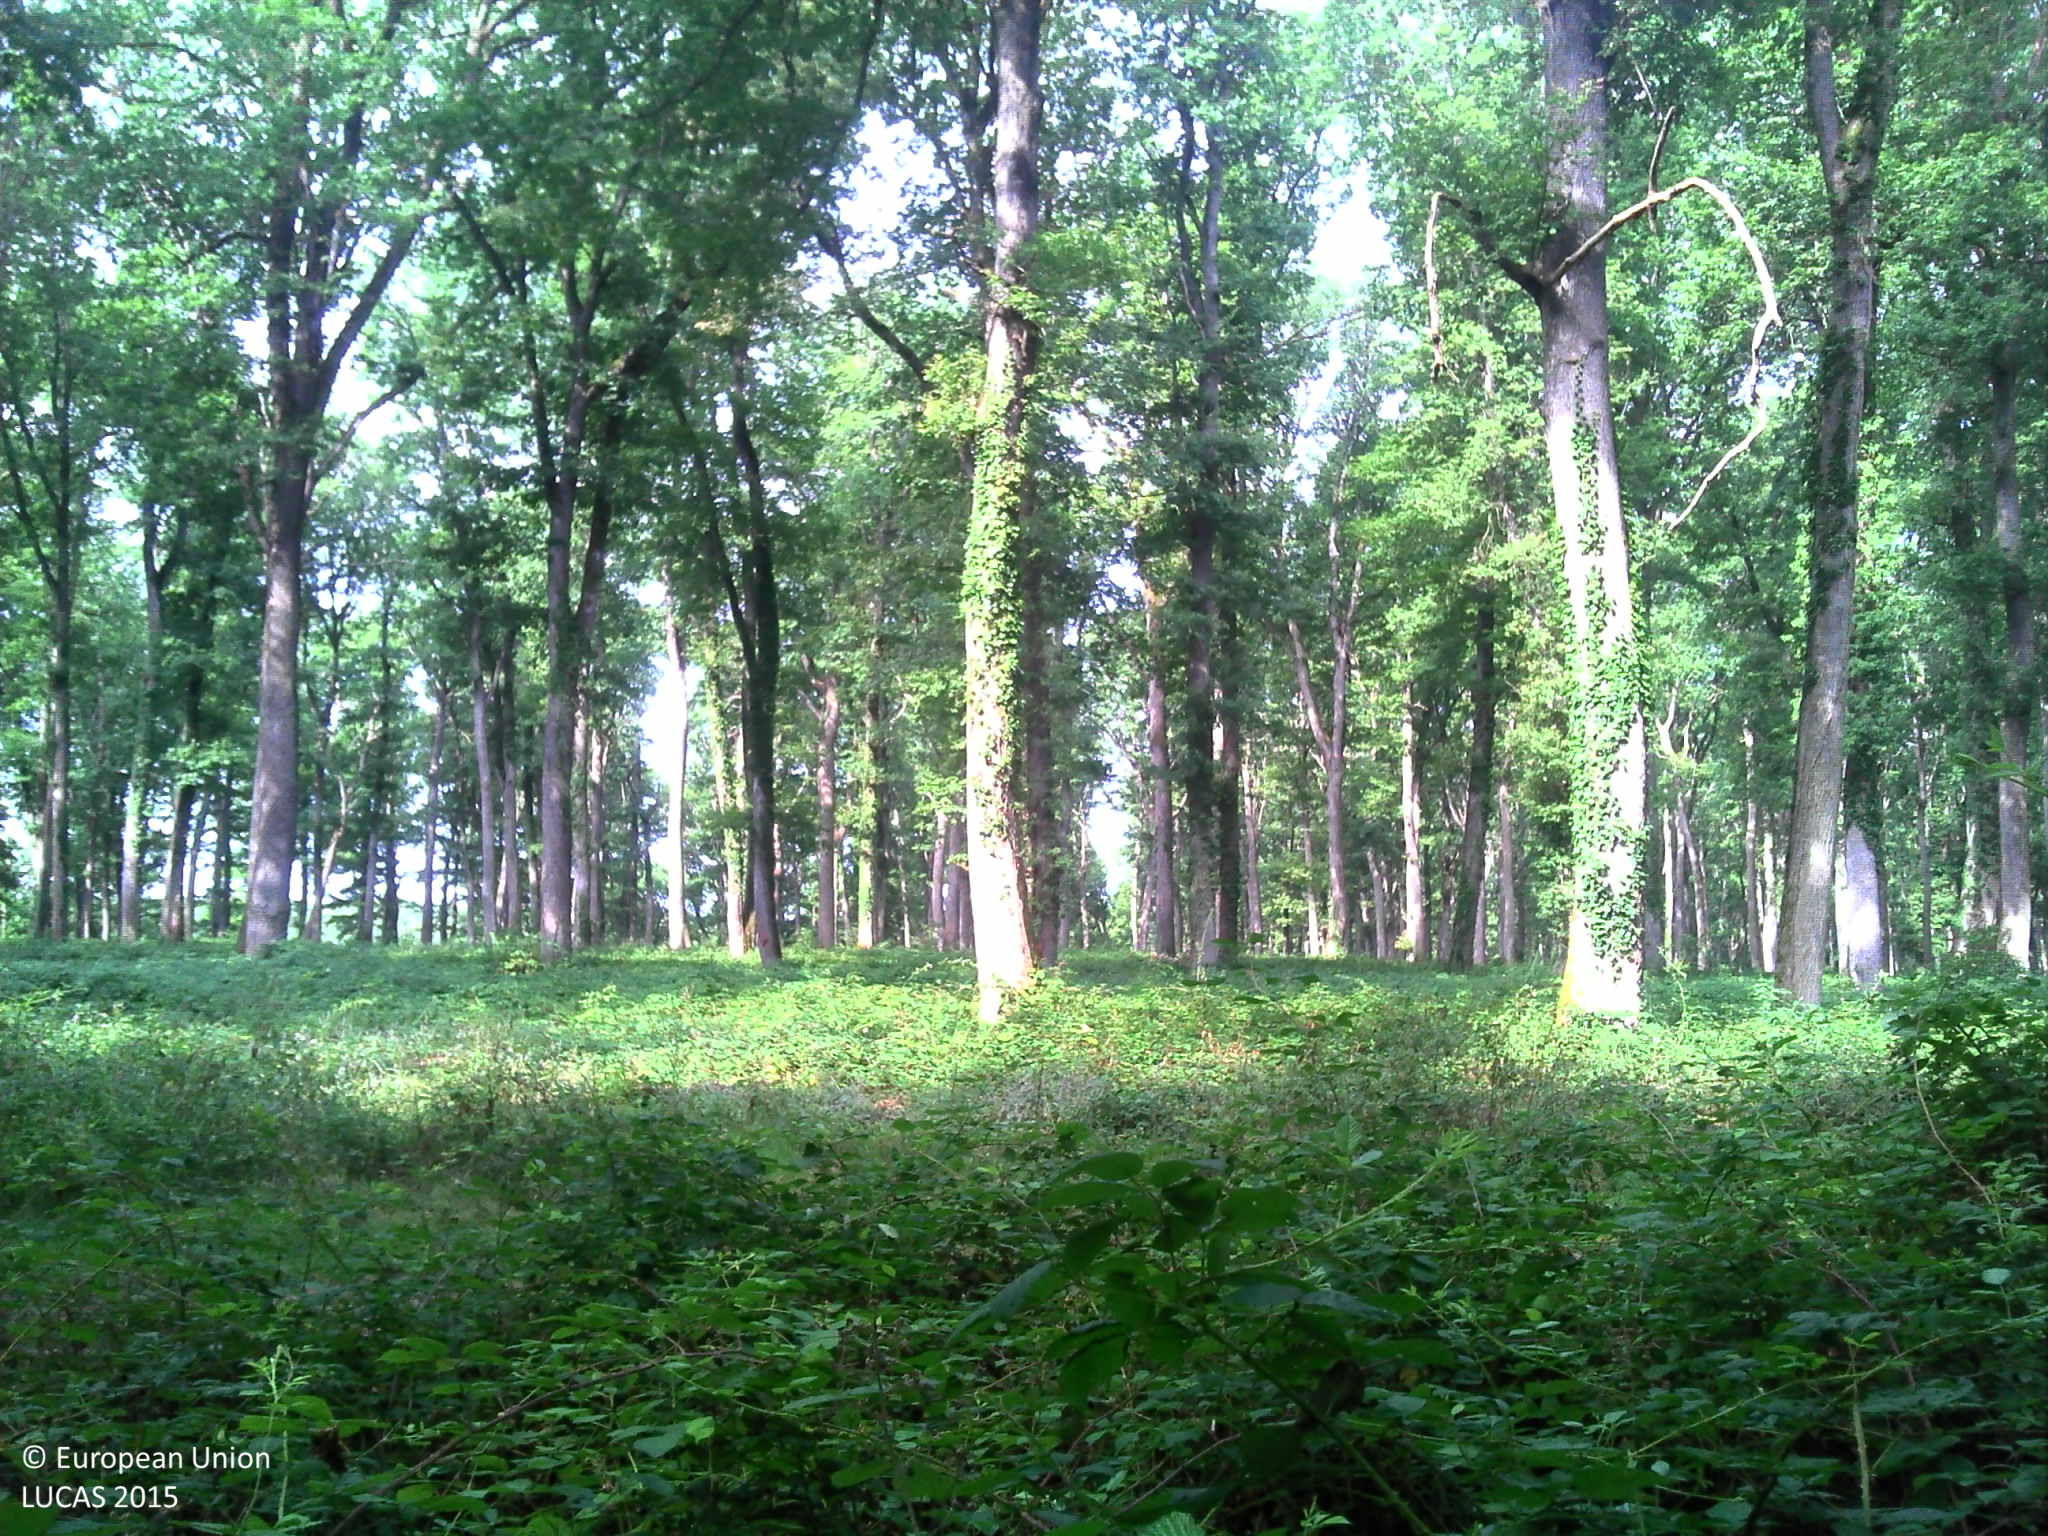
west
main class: Woodland
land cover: Broadleaved woodland
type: mesophytic deciduous forest
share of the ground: > 75 %
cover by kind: broadleaved forest trees 90 %, shrubs 10 %
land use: Forestry
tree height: > 5 m
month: August
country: FR
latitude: 46.5000
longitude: 3.2614
